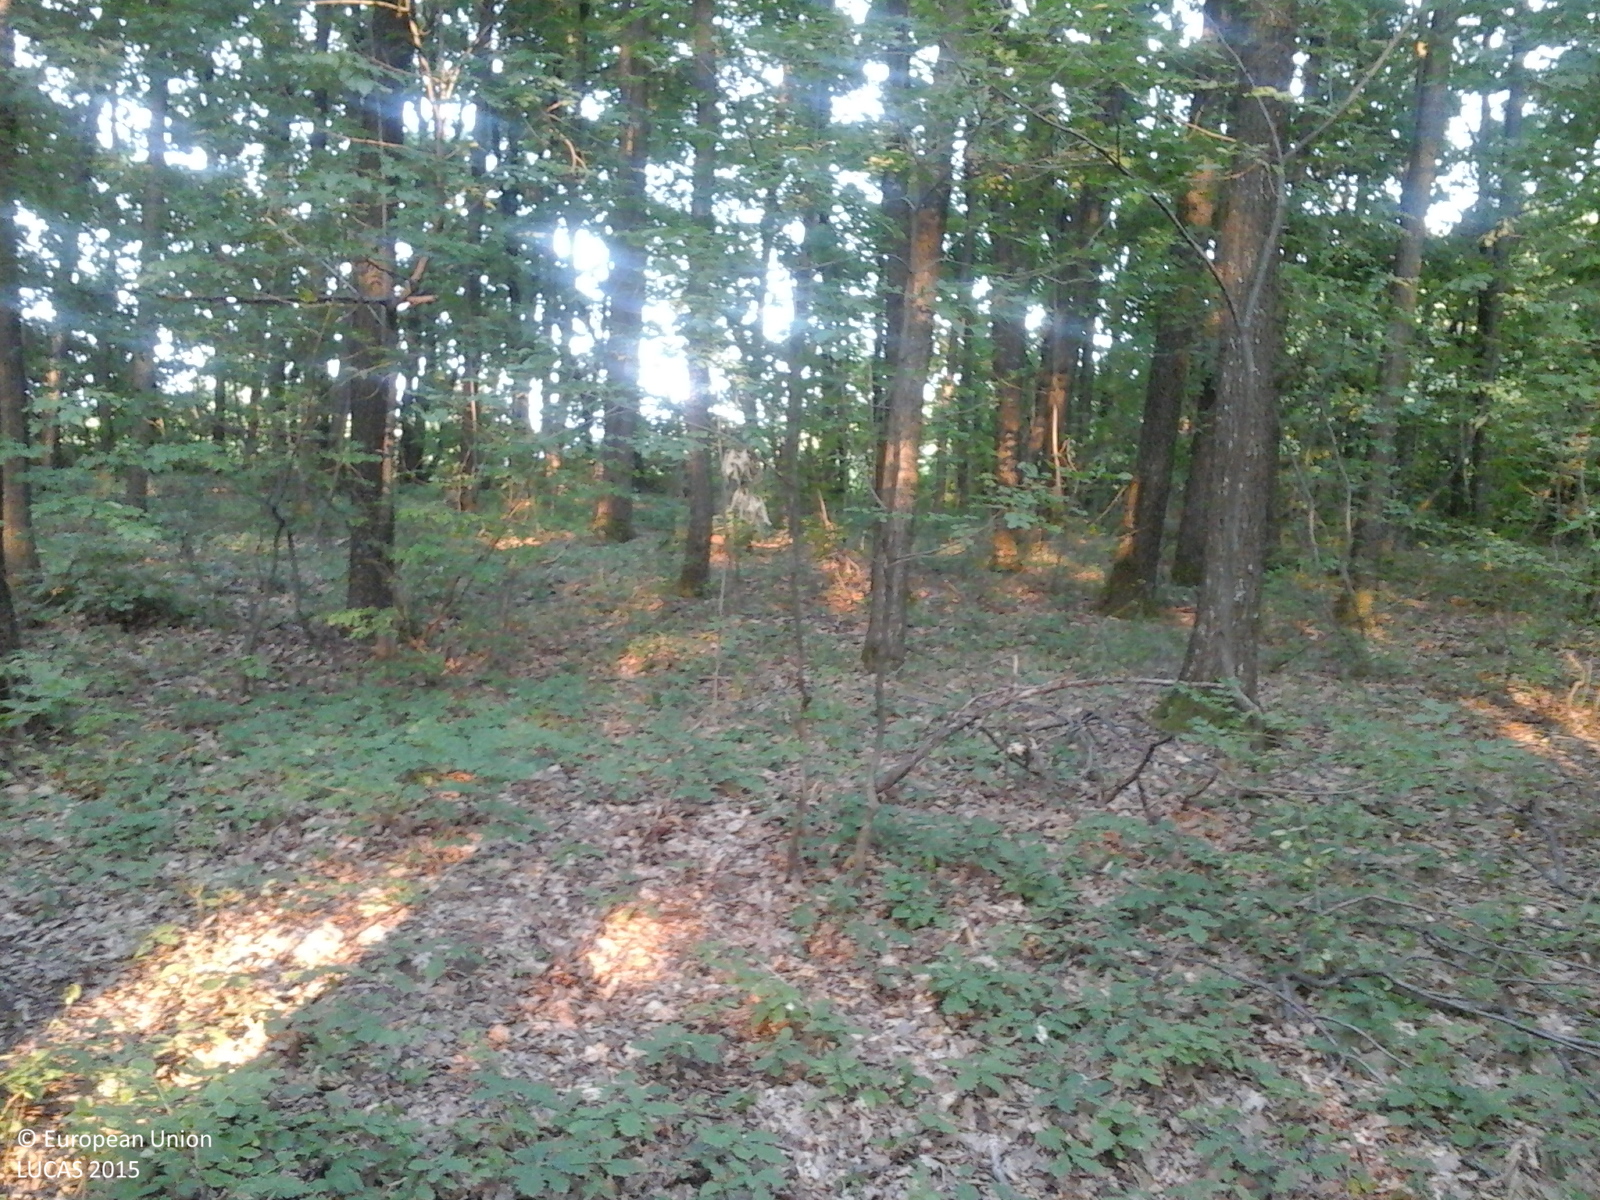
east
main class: Woodland
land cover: Broadleaved woodland
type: acidophilous oak and oak-birch forest
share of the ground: > 75 %
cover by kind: broadleaved forest trees 100 %
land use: Forestry
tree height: > 5 m
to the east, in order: Broadleaved woodland; Tracks; Grassland with sparse tree/shrub cover; Tracks; Shrubland with sparse tree cover; Tracks; Spontaneously vegetated surfaces; Broadleaved woodland
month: July
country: RO
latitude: 44.8469
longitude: 24.7428
